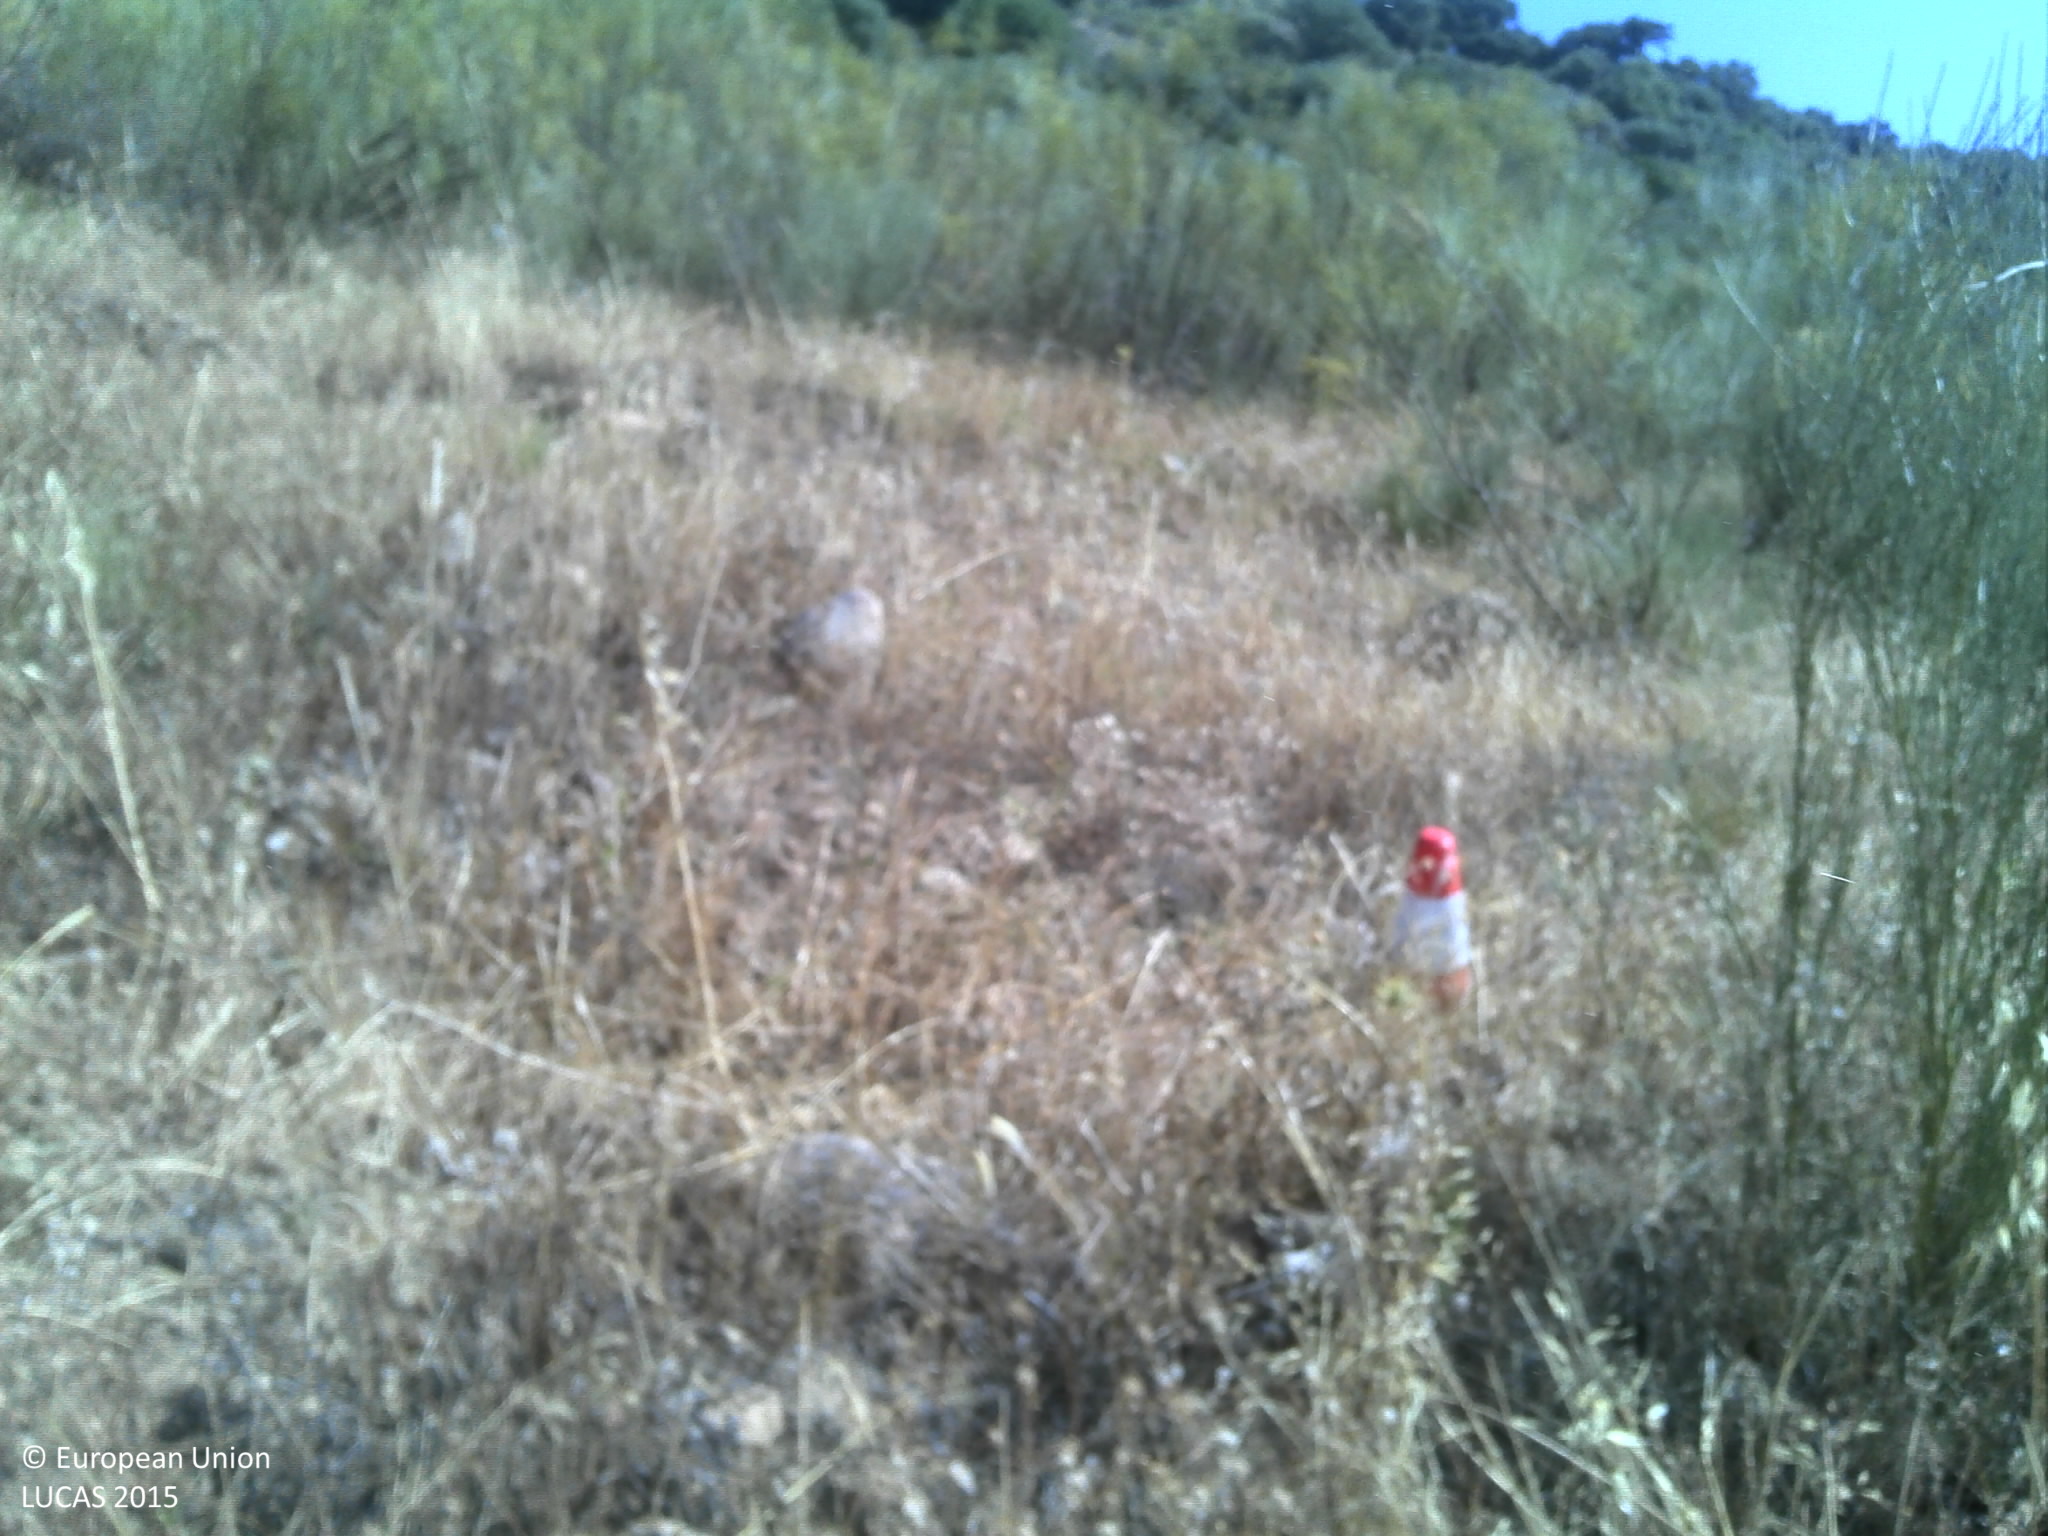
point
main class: Shrubland
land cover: Shrubland with sparse tree cover
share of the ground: 25 - 50 %
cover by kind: shrubs 30 %, herbaceous plants 30 %, unconsolidated bare surface 30 %, broadleaved forest trees 5 %
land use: Agriculture (excluding fallow land and kitchen gardens)
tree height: < 5 m
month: June
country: PT
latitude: 39.9022
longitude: -7.2776
